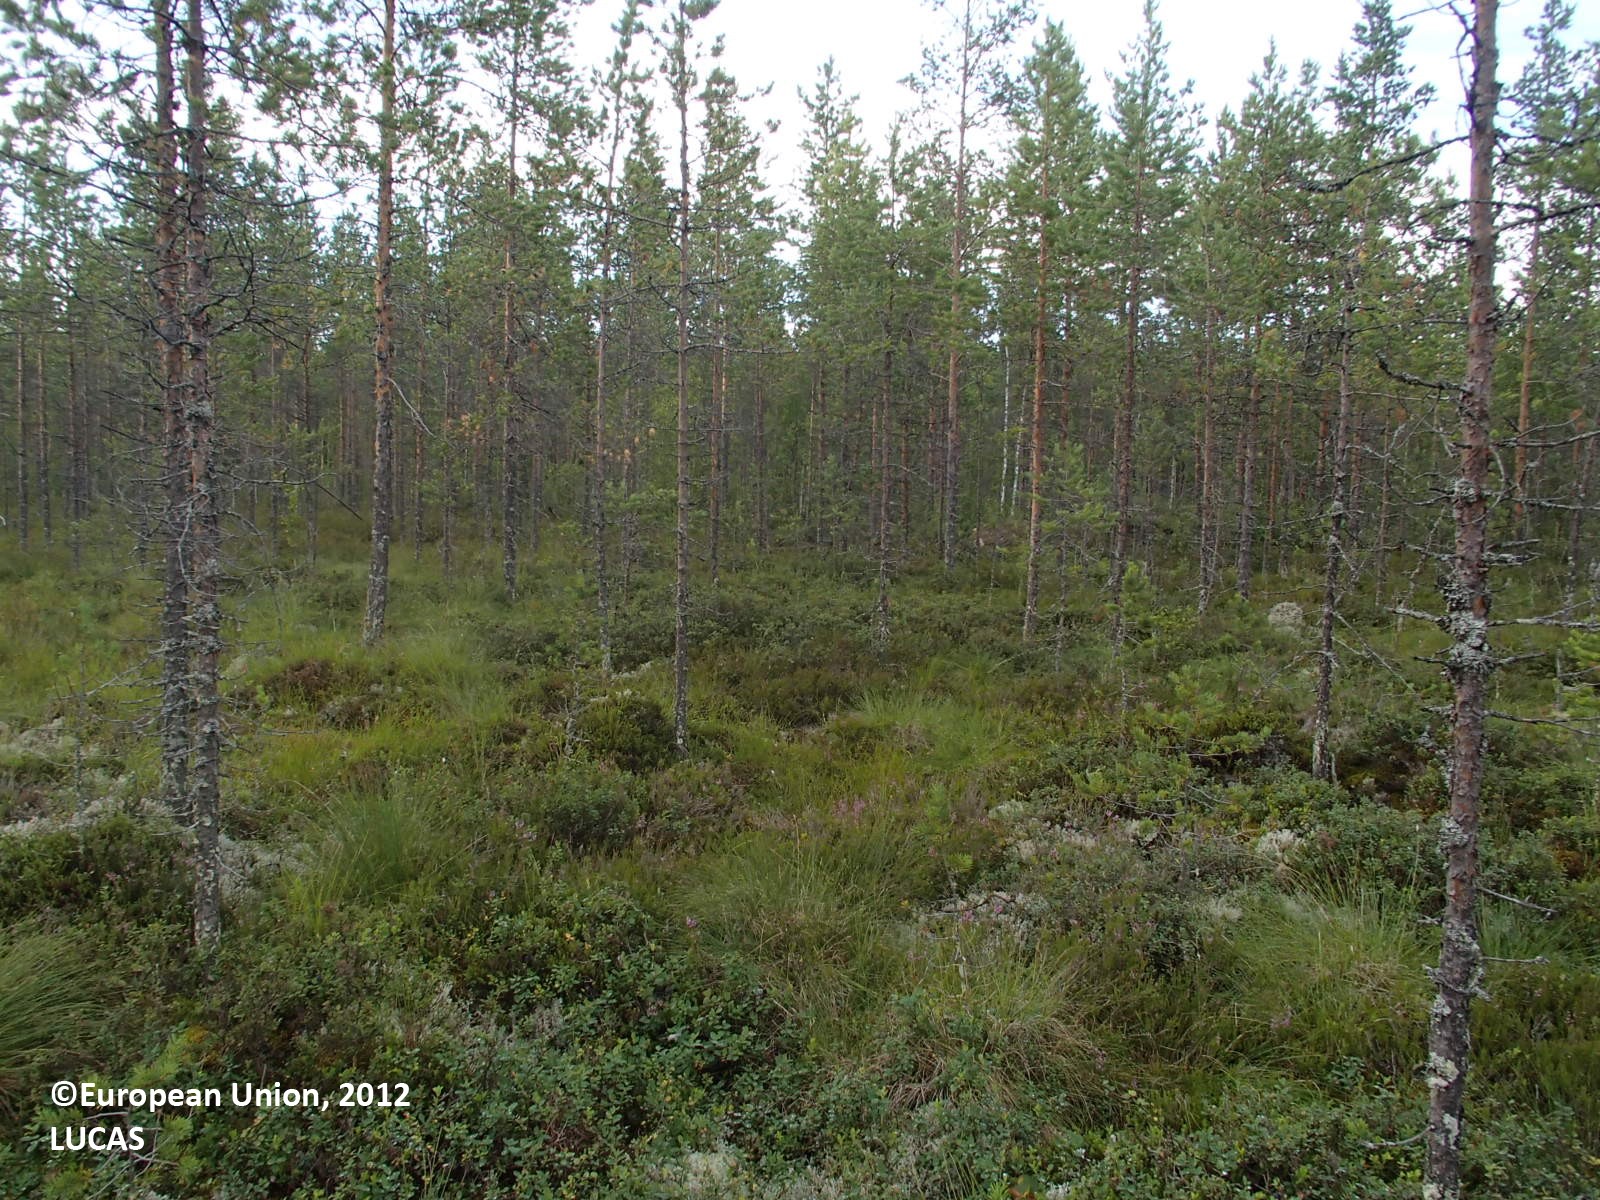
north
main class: Woodland
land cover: Pine dominated coniferous woodland
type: boreal forest
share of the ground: 10 - 25 %
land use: Forestry
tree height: > 5 m
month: August
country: FI
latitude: 64.1011
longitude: 26.1361
